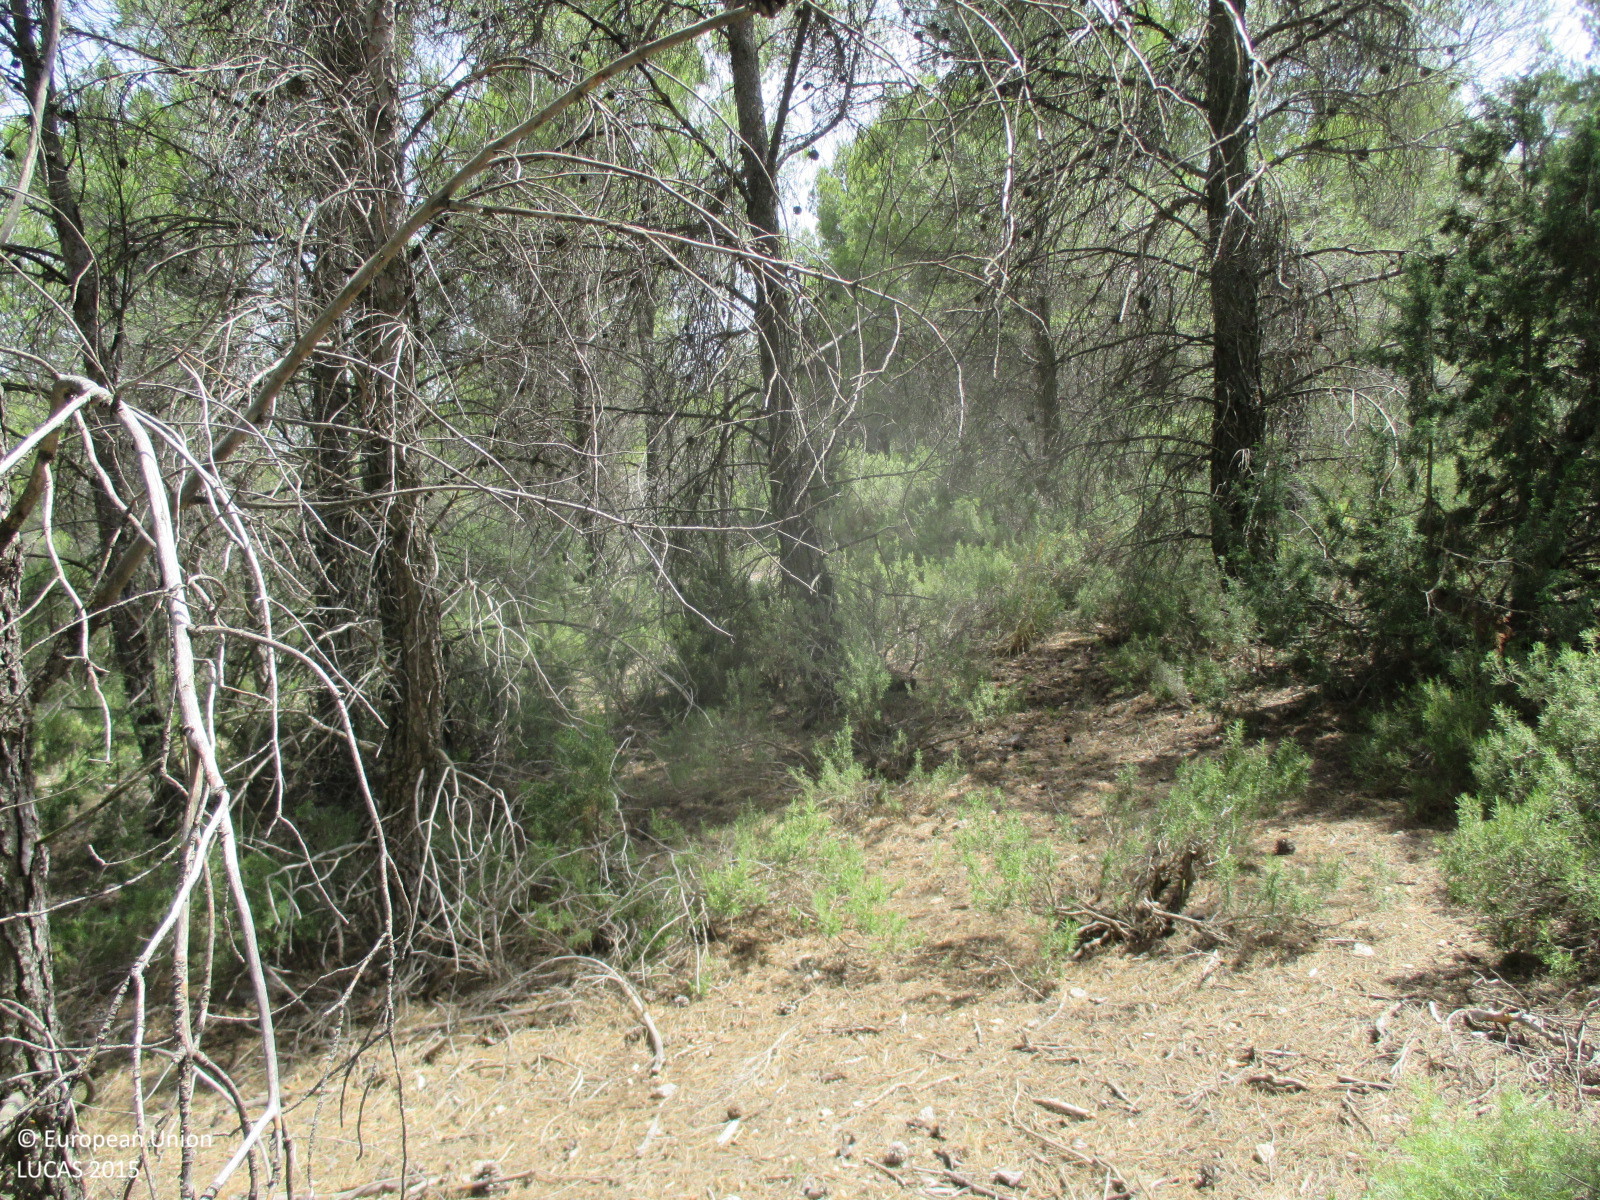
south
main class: Woodland
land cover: Pine dominated coniferous woodland
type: coniferous forest of the mediterranean region
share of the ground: > 75 %
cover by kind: coniferous forest trees 80 %, shrubs 10 %, herbaceous plants 10 %
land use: Forestry
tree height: > 5 m
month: July
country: ES
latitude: 37.9396
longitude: -2.4048
